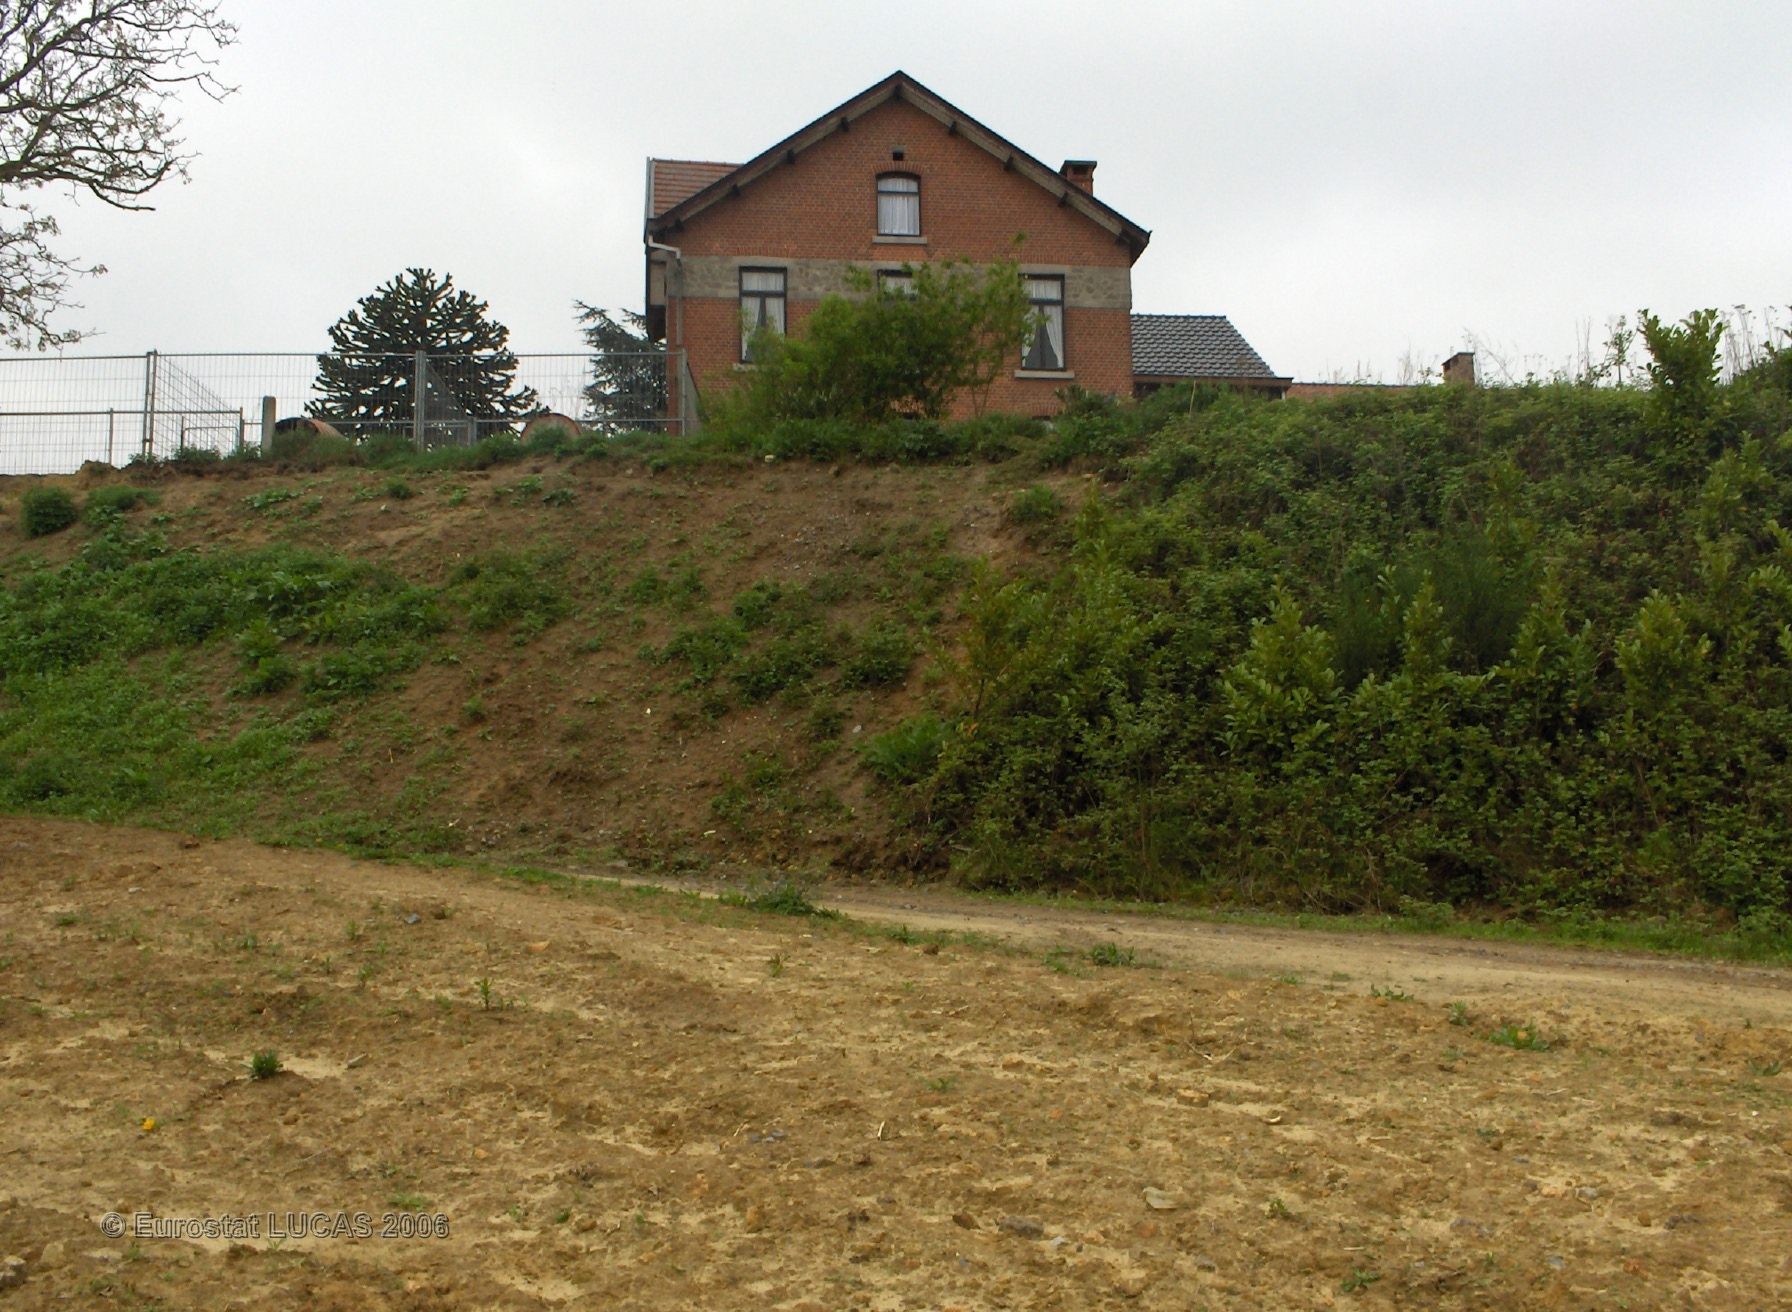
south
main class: Water areas
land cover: Inland water bodies
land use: Unused
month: May
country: BE
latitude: 50.5591
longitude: 4.5613
